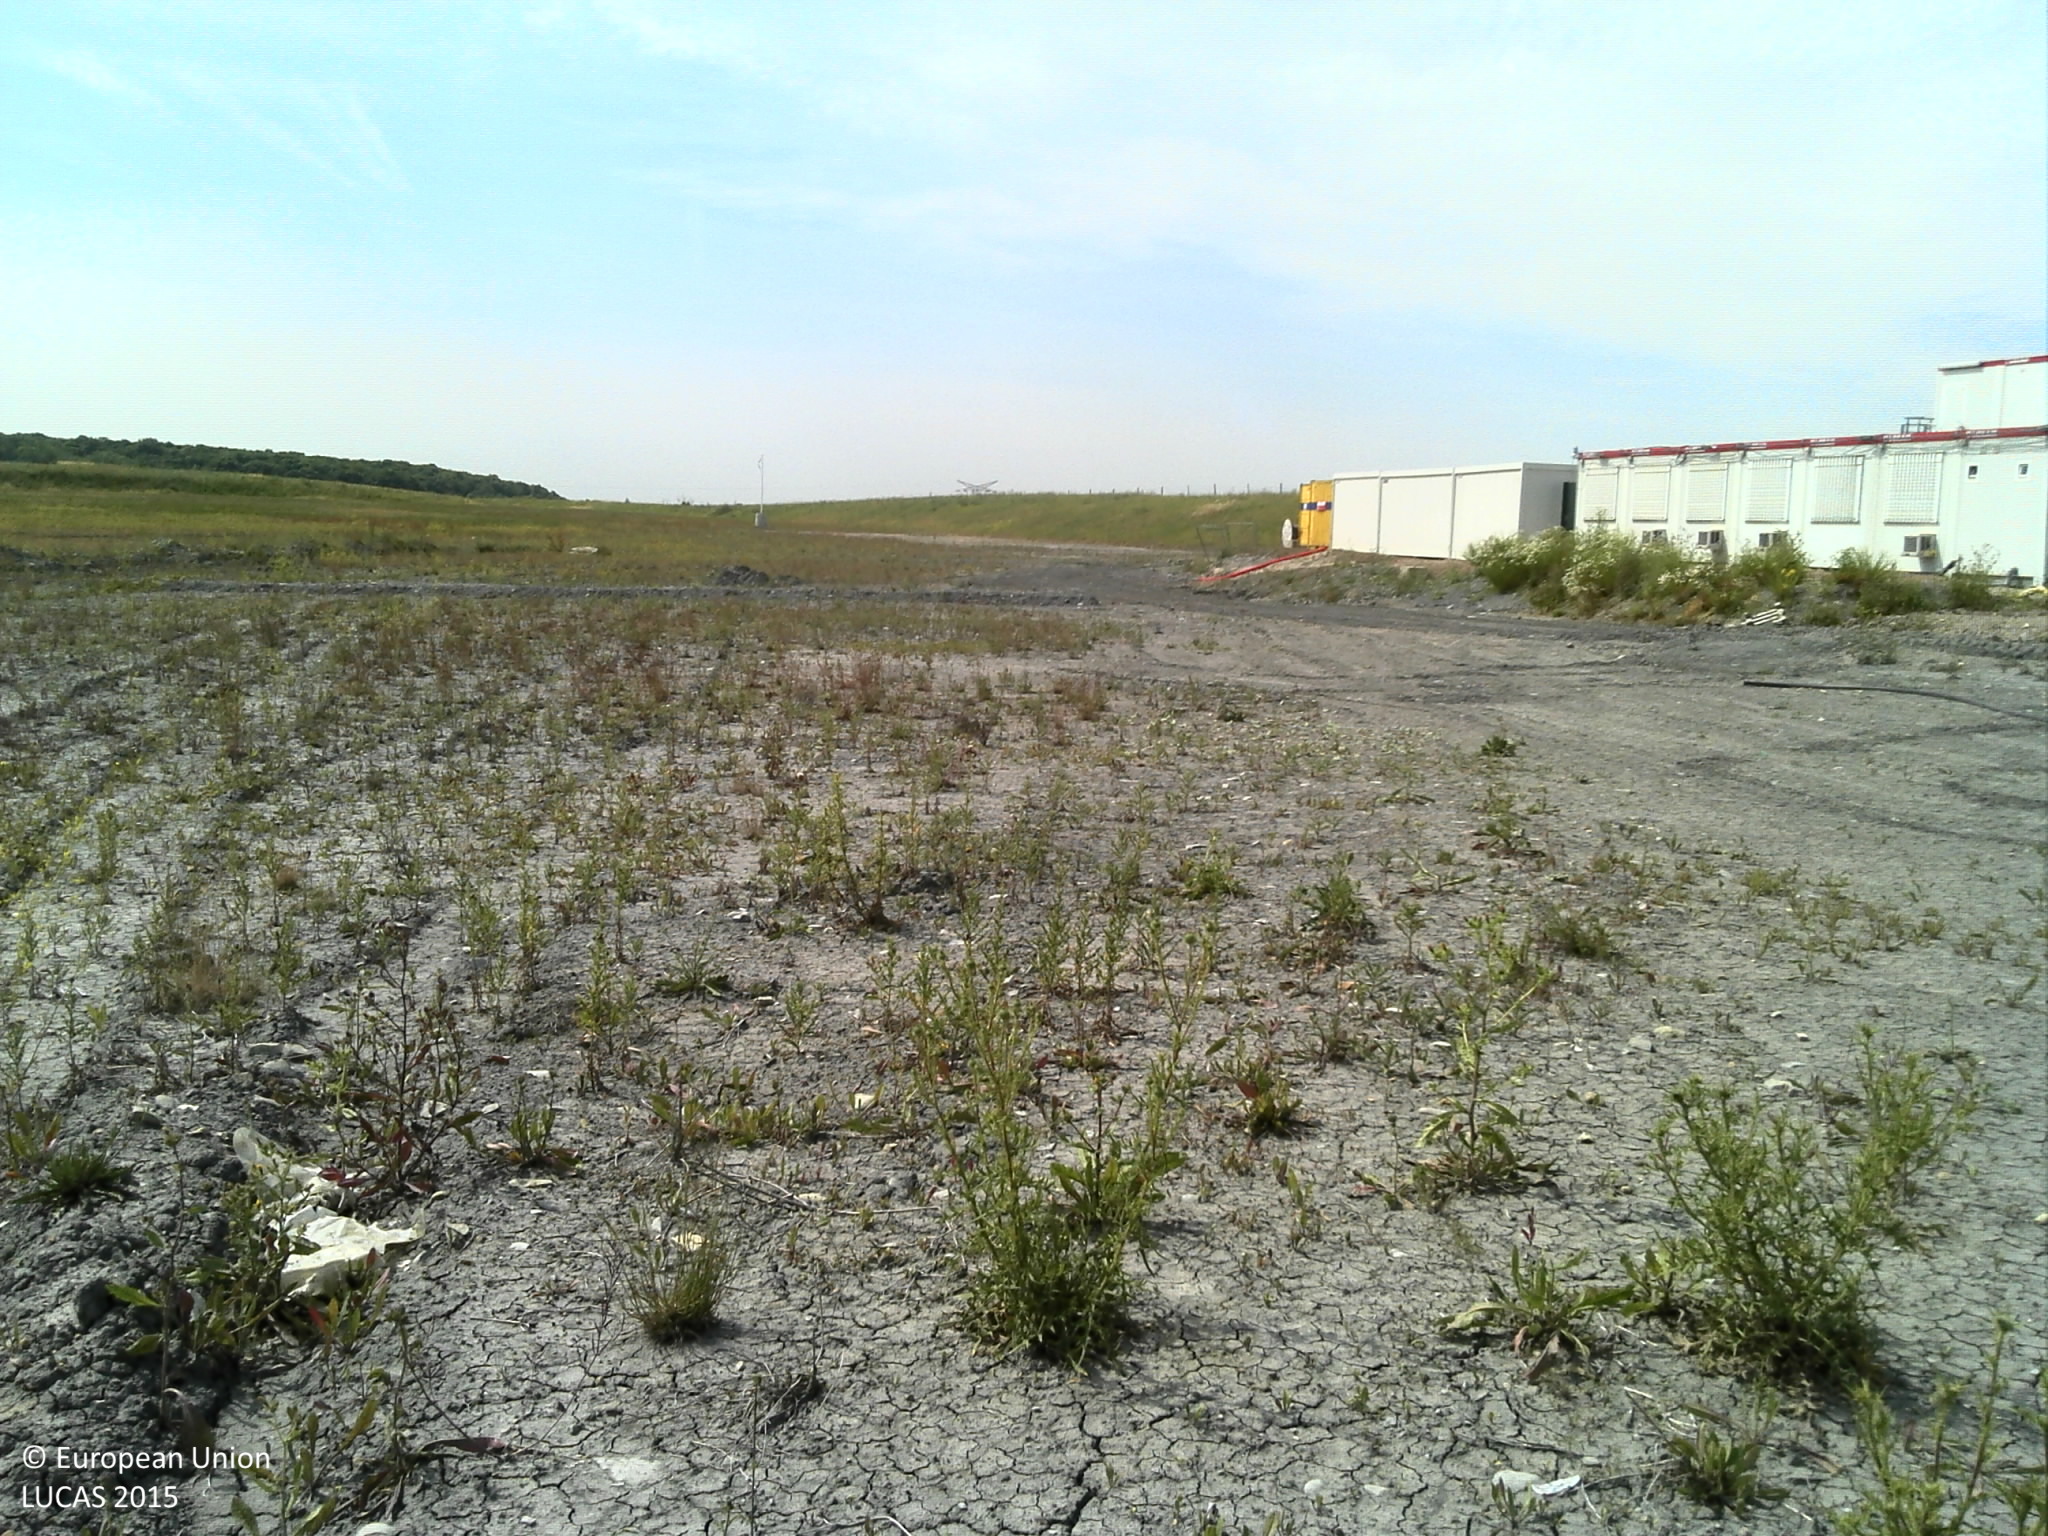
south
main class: Grassland
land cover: Spontaneously vegetated surfaces
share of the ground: 25 - 50 %
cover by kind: unconsolidated bare surface 60 %, herbaceous plants 40 %
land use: Semi-natural and natural areas not in use
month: June
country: FR
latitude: 49.3284
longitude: 6.1882
